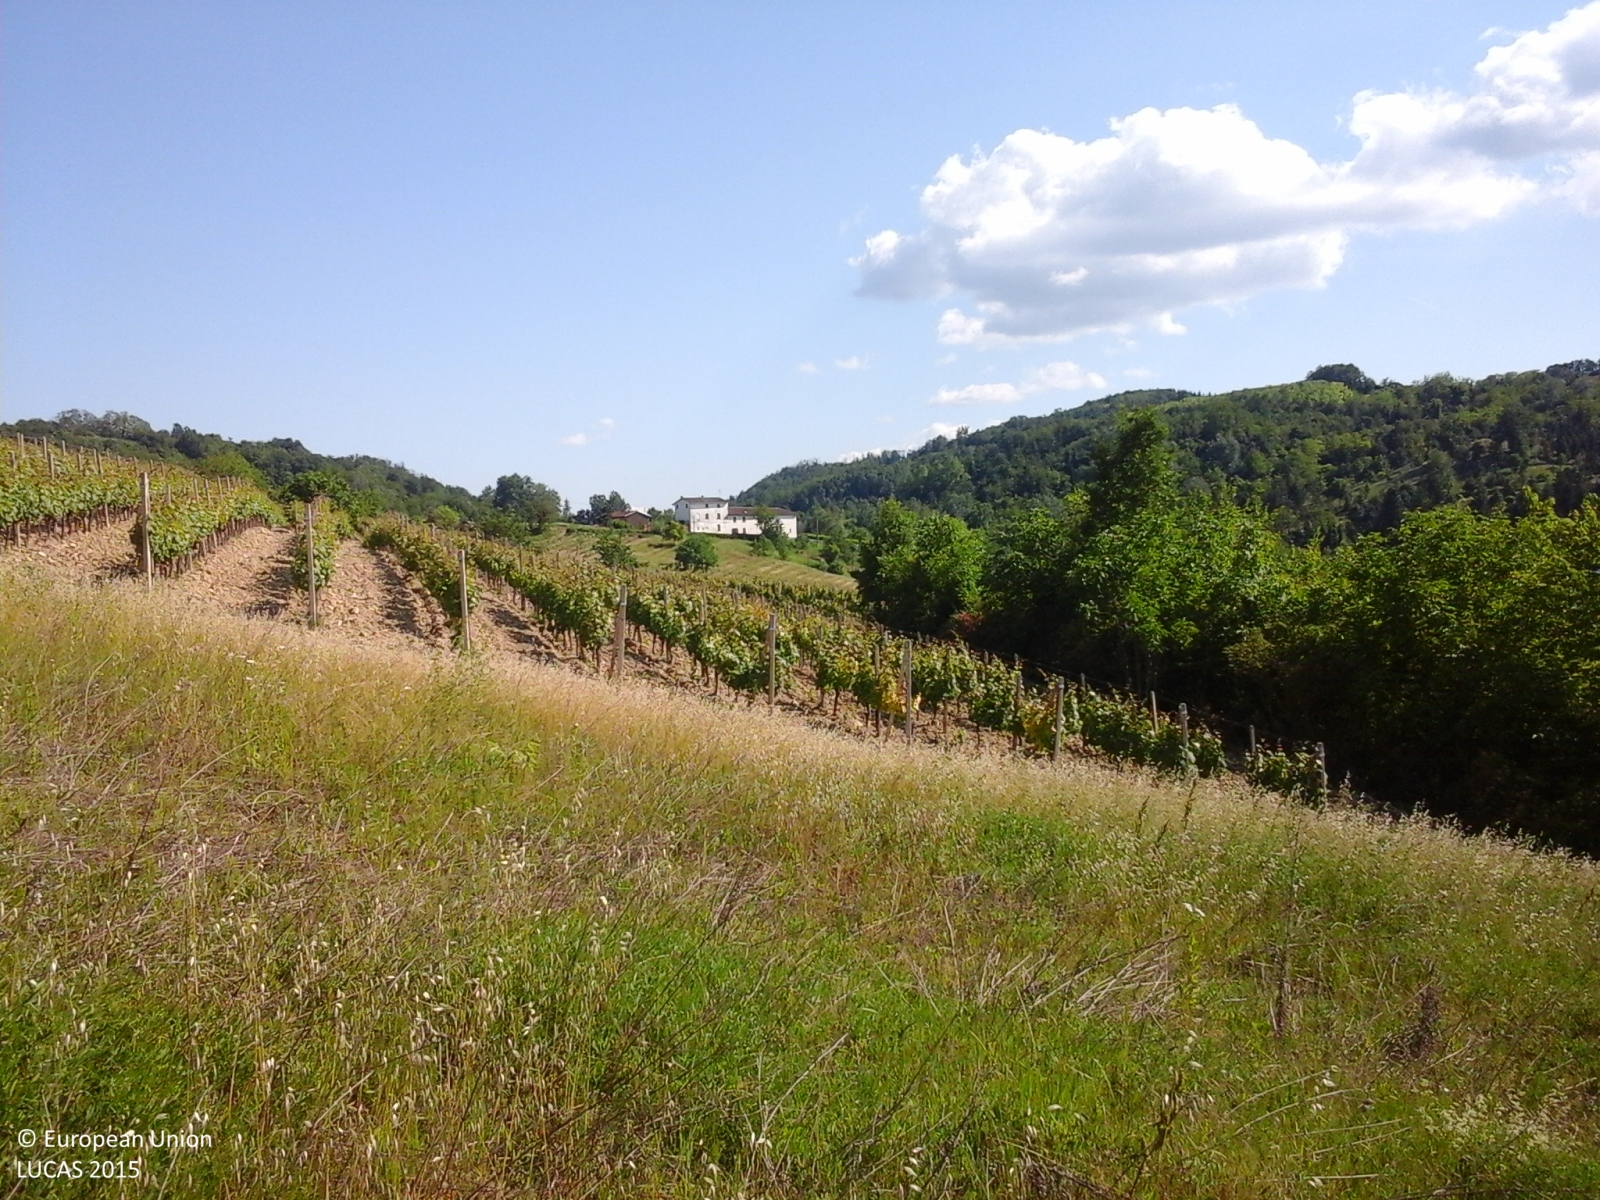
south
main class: Grassland
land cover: Spontaneously vegetated surfaces
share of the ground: > 75 %
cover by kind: herbaceous plants 100 %
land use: Fallow land
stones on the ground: < 10 %
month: May
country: IT
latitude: 44.7015
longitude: 8.5768
